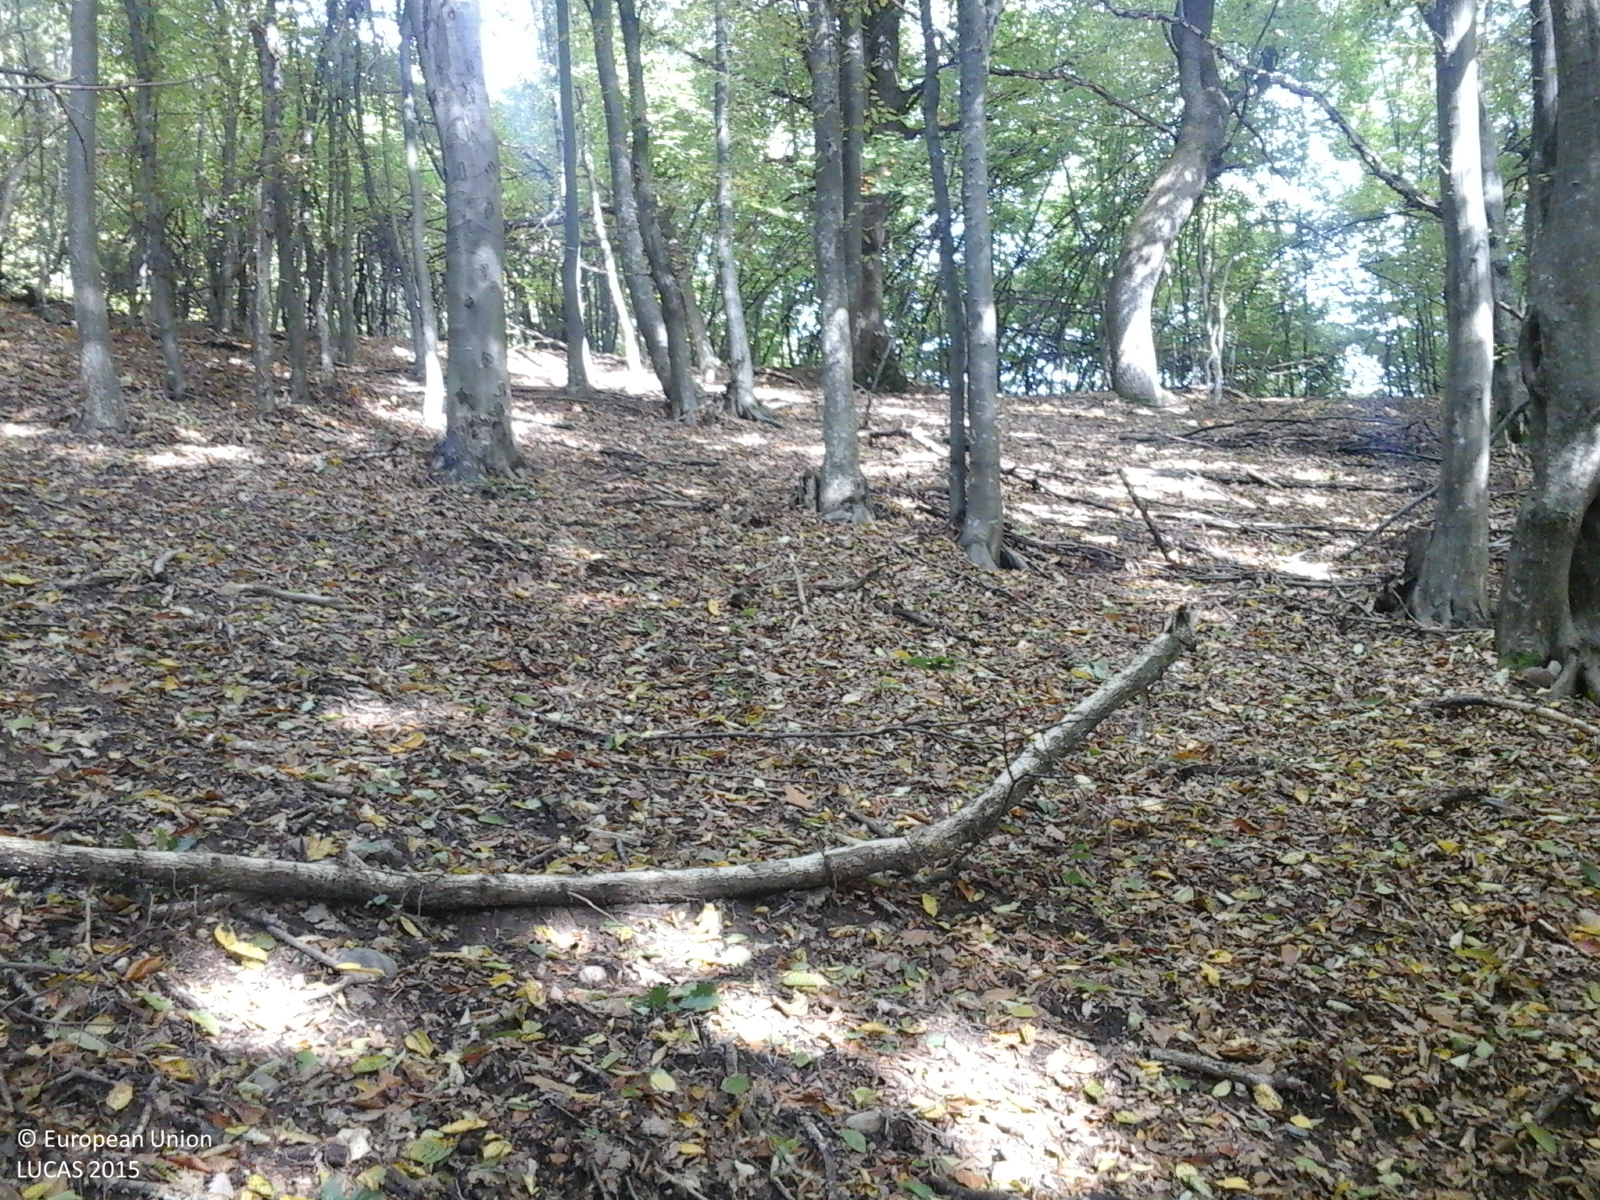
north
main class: Woodland
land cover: Broadleaved woodland
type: mesophytic deciduous forest
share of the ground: > 75 %
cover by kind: broadleaved forest trees 100 %
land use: Forestry
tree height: > 5 m
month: October
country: RO
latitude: 46.4174
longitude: 25.1535
